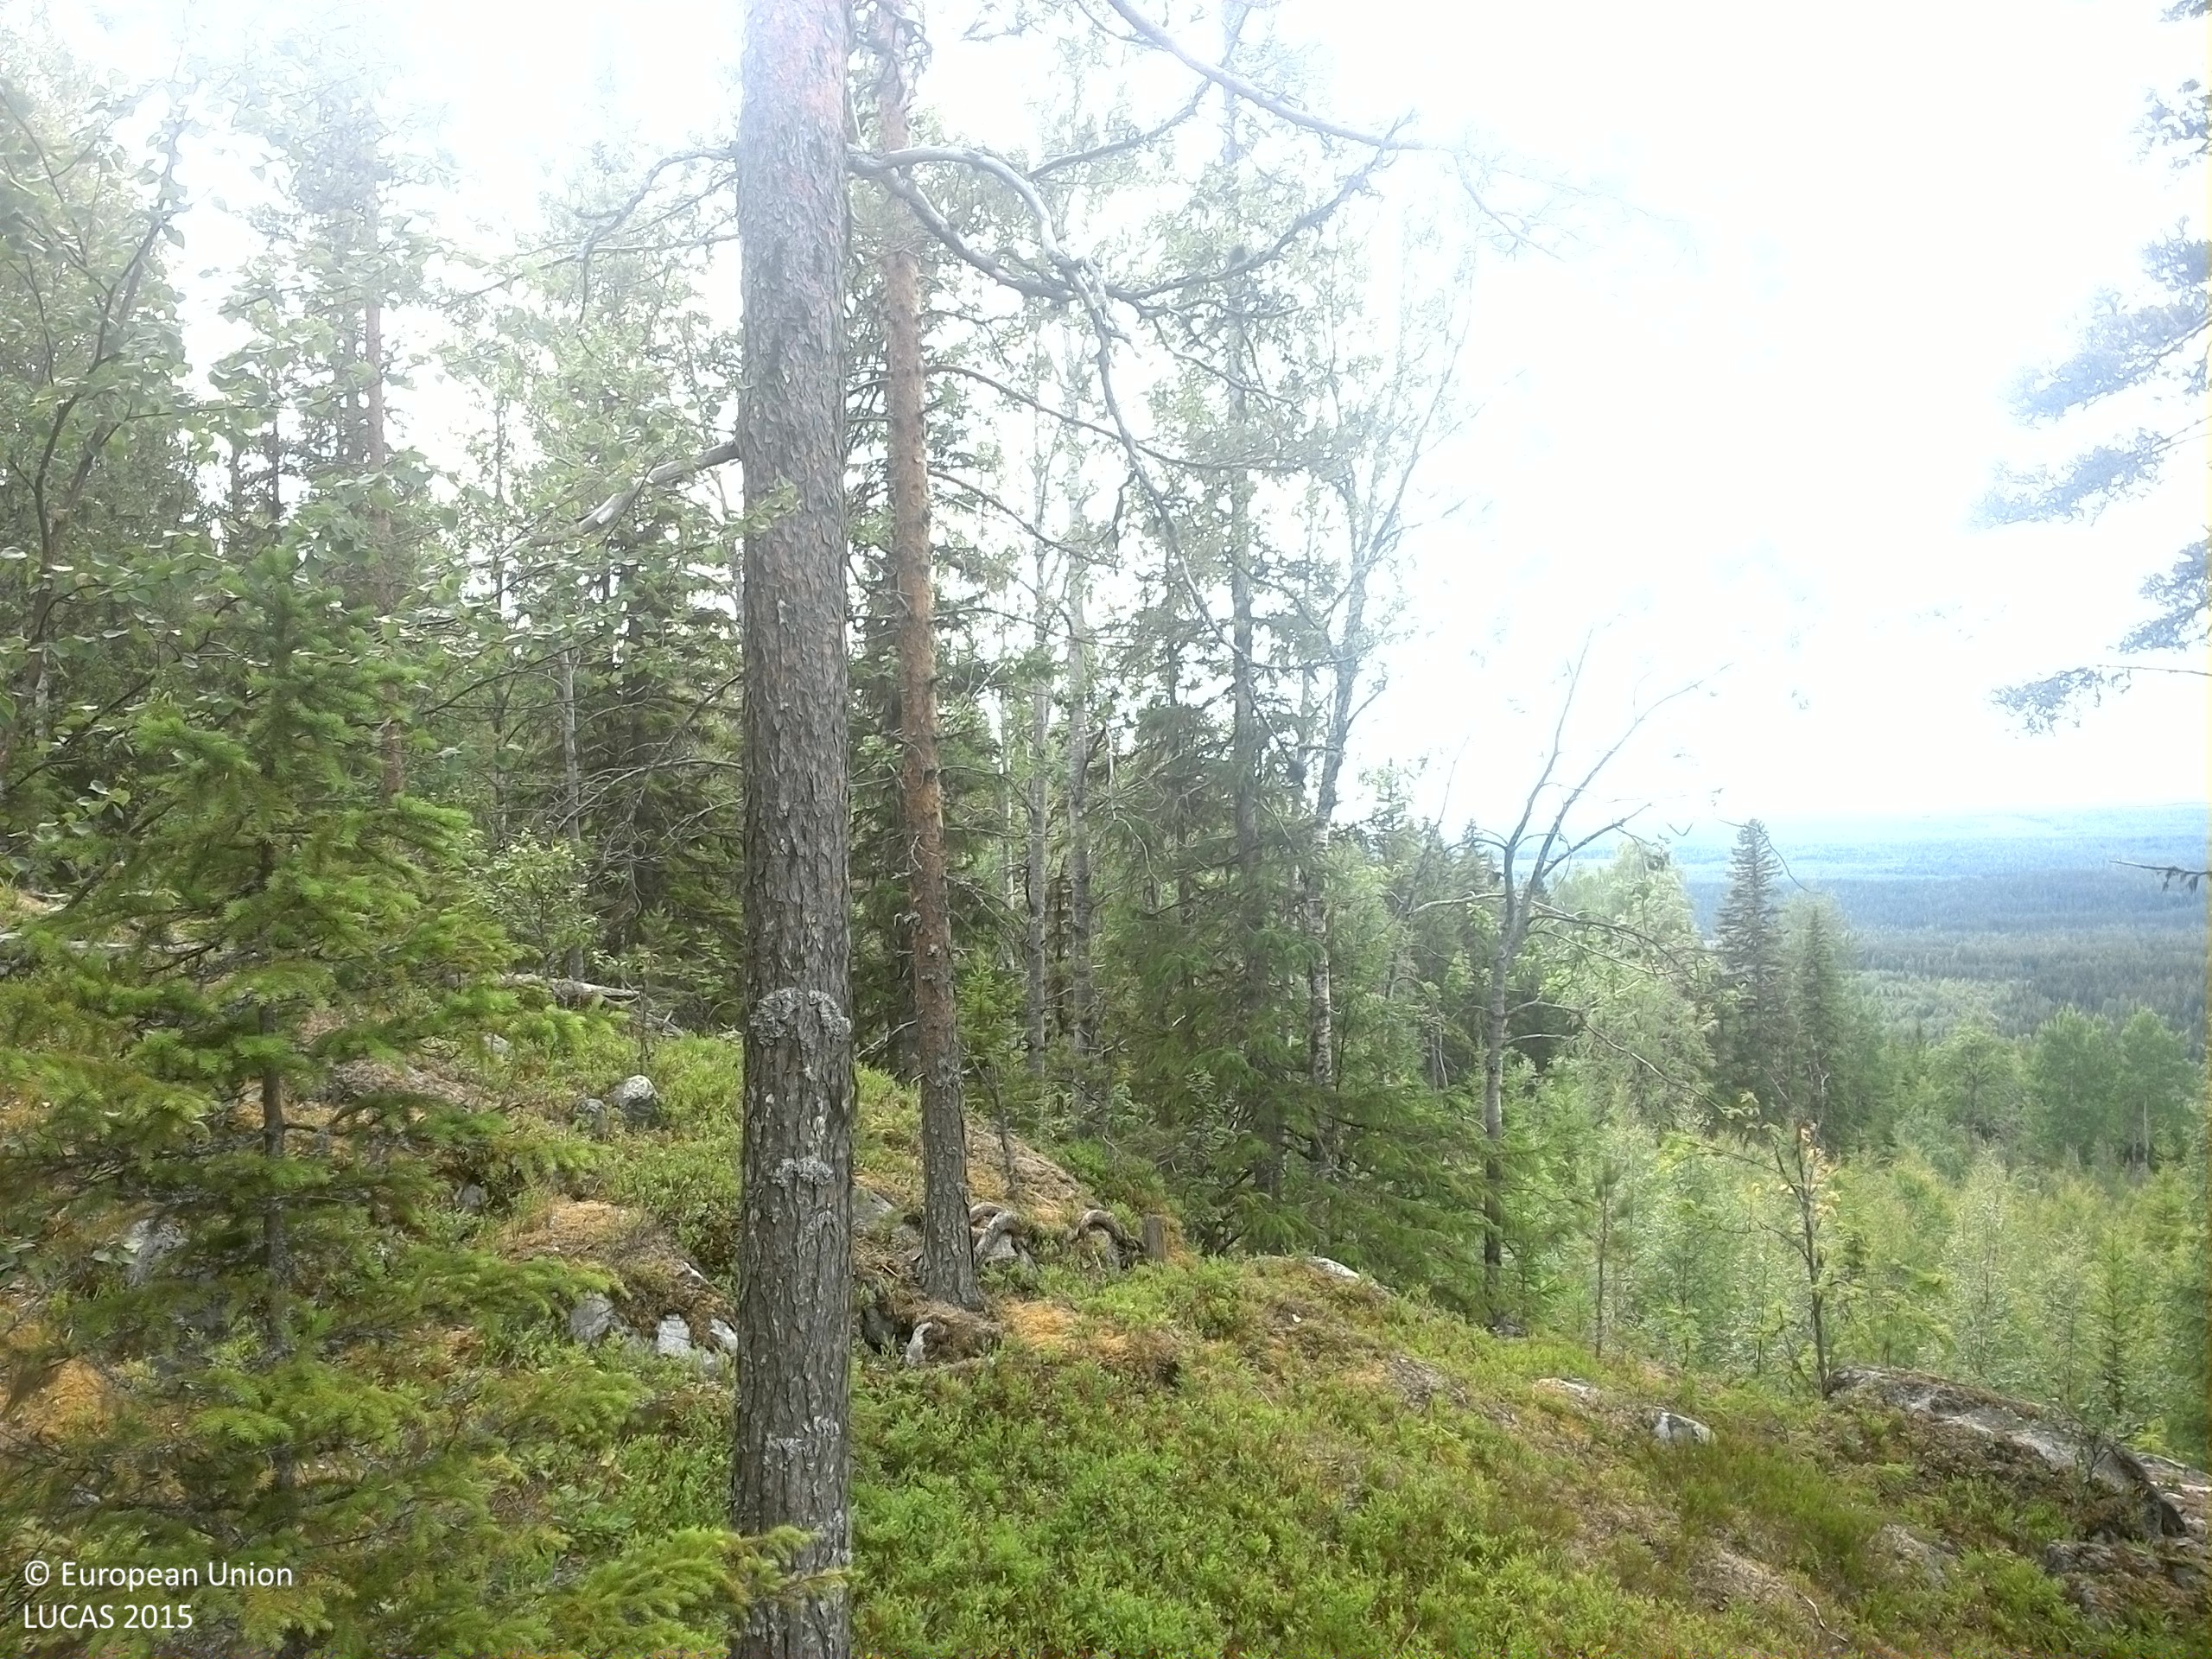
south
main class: Woodland
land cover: Pine dominated mixed woodland
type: boreal forest
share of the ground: 50 - 75 %
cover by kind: coniferous forest trees 45 %, shrubs 20 %, broadleaved forest trees 15 %, lichens and mosses 10 %, consolidated bare surface 10 %
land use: Forestry
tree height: > 5 m
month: July
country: SE
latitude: 63.5665
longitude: 17.8870
